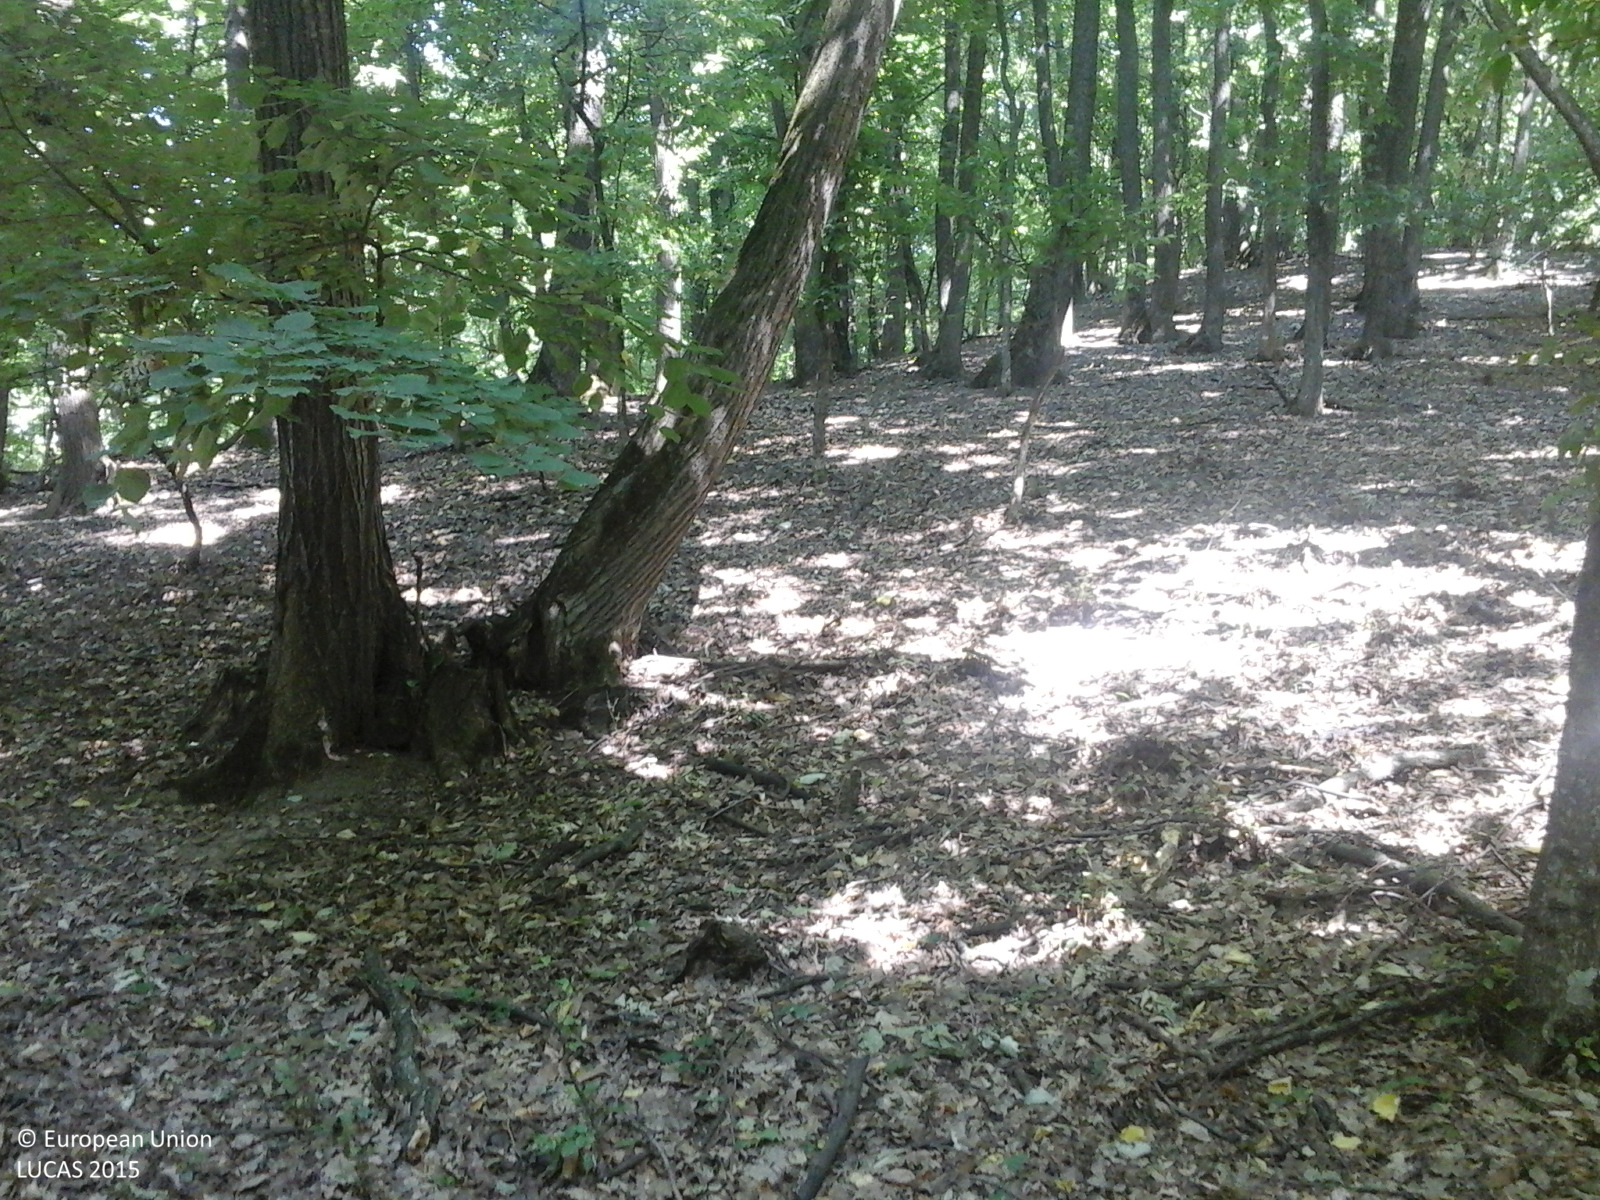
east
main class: Woodland
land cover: Broadleaved woodland
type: beech forest
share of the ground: > 75 %
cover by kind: broadleaved forest trees 100 %
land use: Forestry
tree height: > 5 m
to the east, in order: Broadleaved woodland
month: June
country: RO
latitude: 46.8485
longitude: 27.0298
